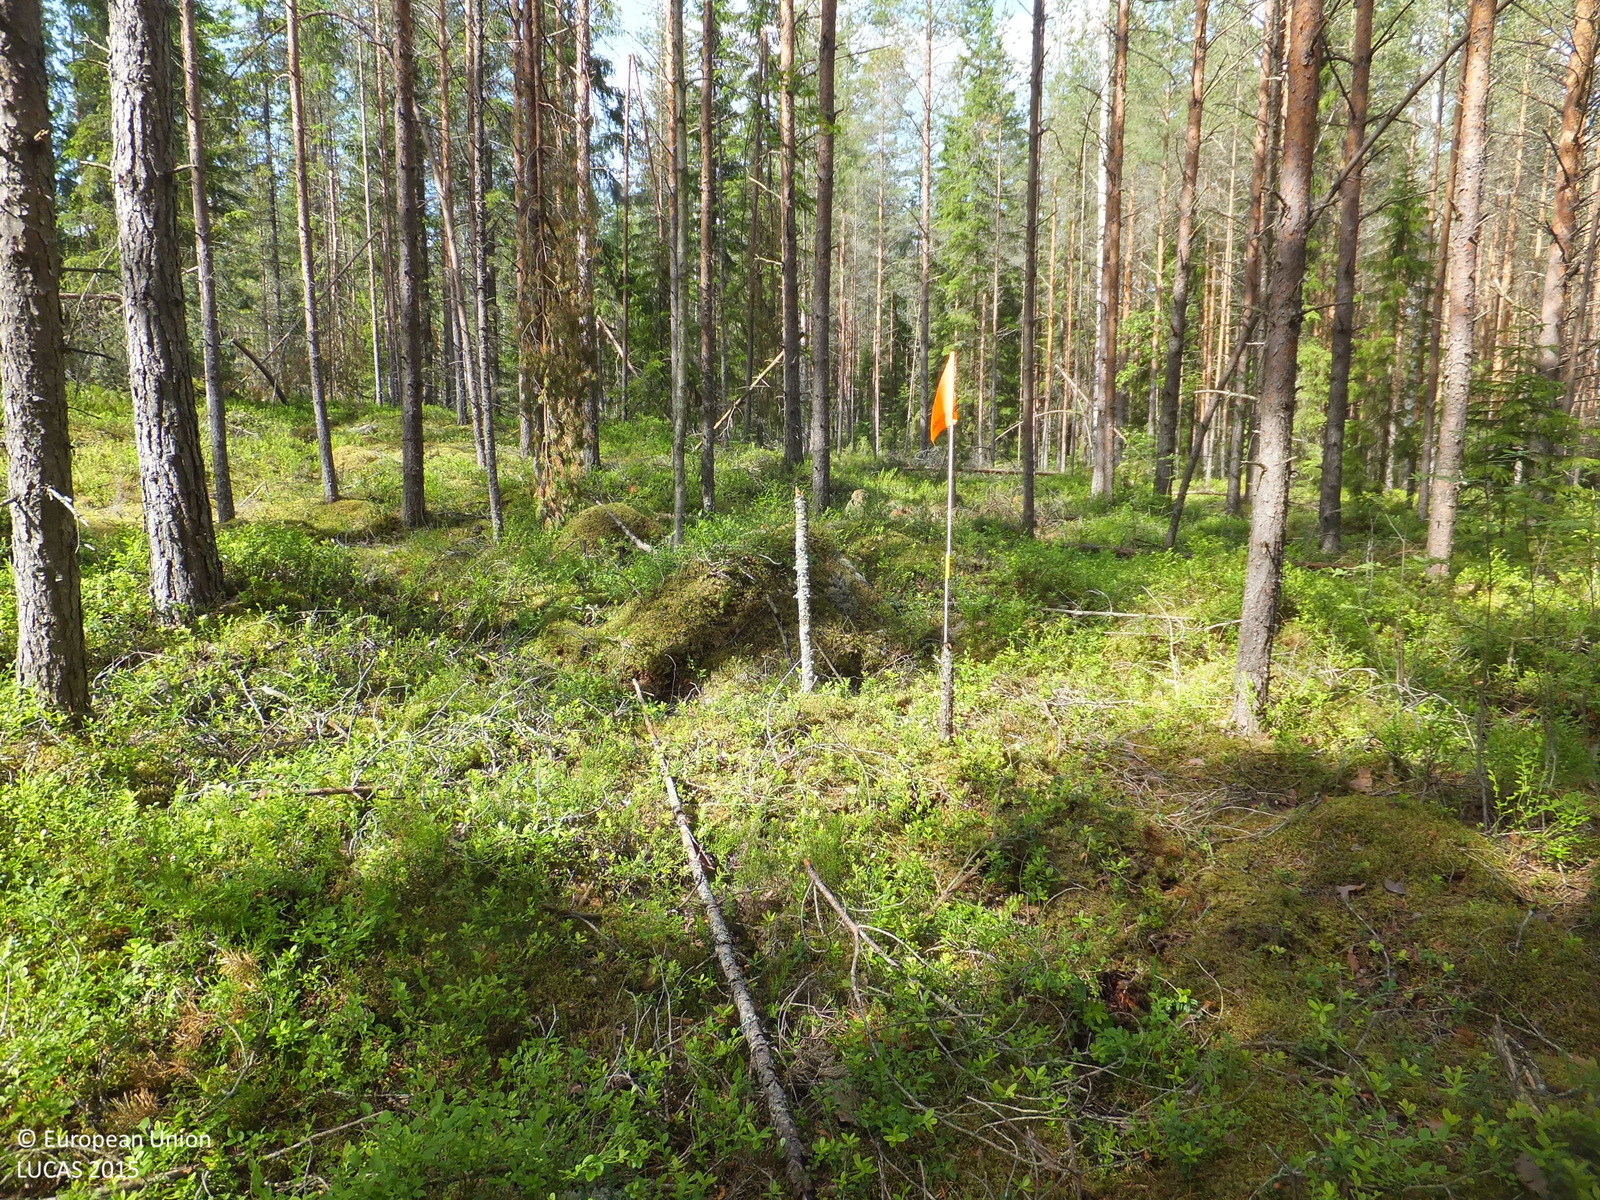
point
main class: Woodland
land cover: Pine dominated coniferous woodland
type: boreal forest
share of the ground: > 75 %
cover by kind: coniferous forest trees 75 %, shrubs 10 %, lichens and mosses 10 %, broadleaved forest trees 5 %
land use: Forestry
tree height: > 5 m
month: July
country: FI
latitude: 63.0791
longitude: 23.9516
